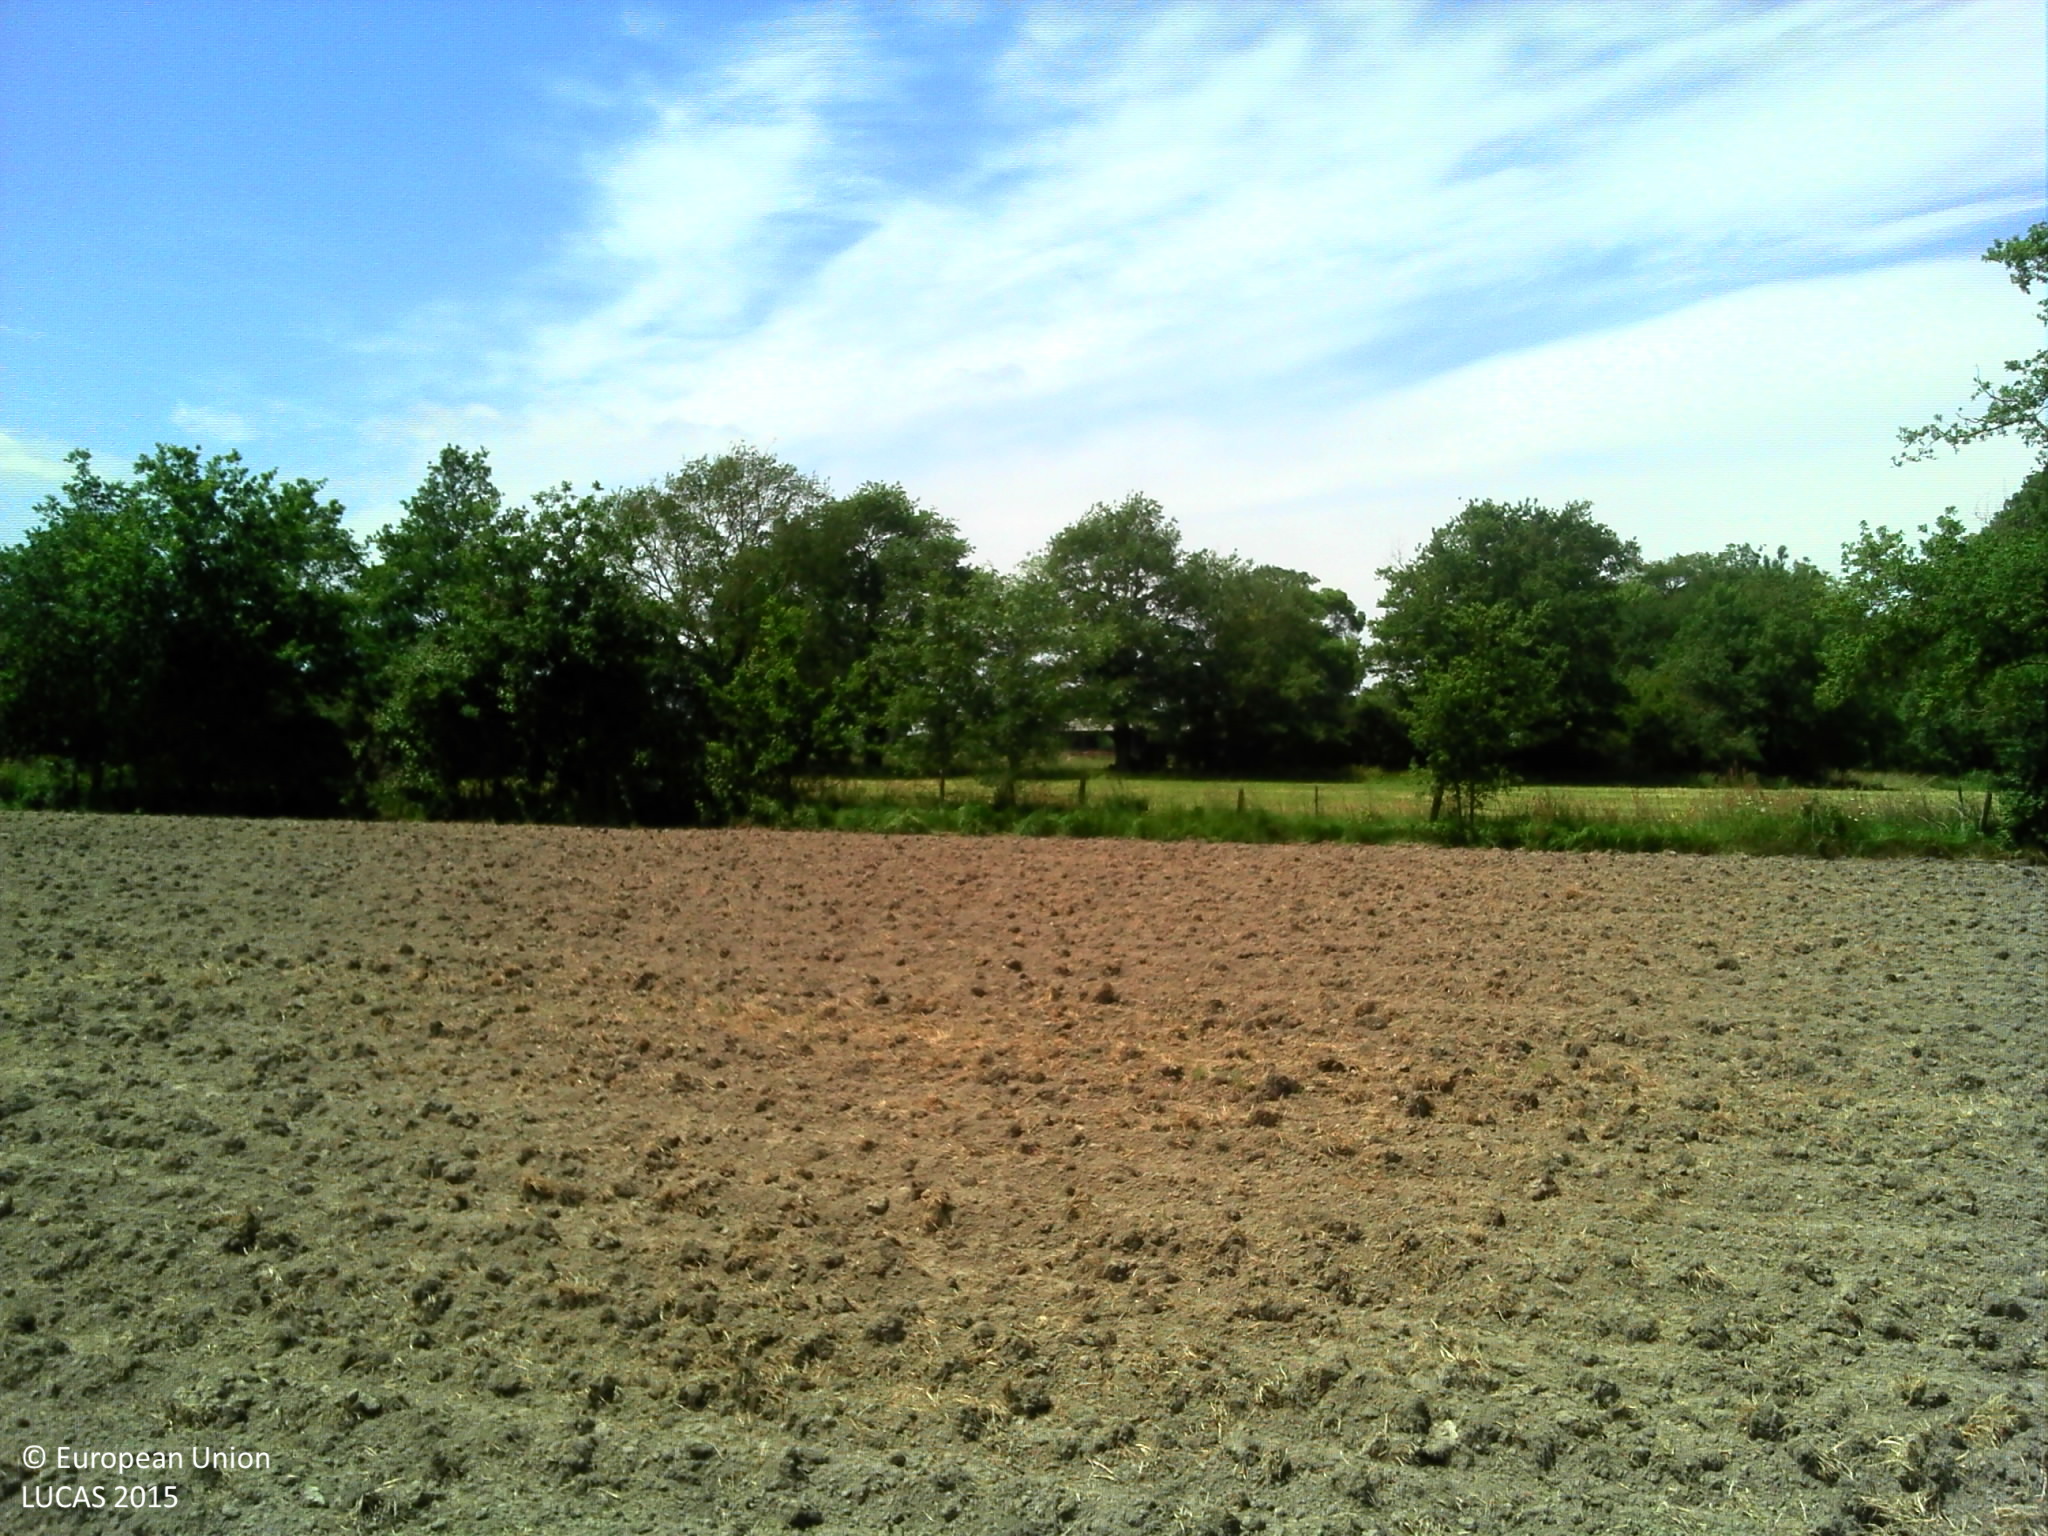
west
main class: Cropland
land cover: Maize
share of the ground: < 10 %
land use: Agriculture (excluding fallow land and kitchen gardens)
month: May
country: FR
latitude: 47.0117
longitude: -1.2312
